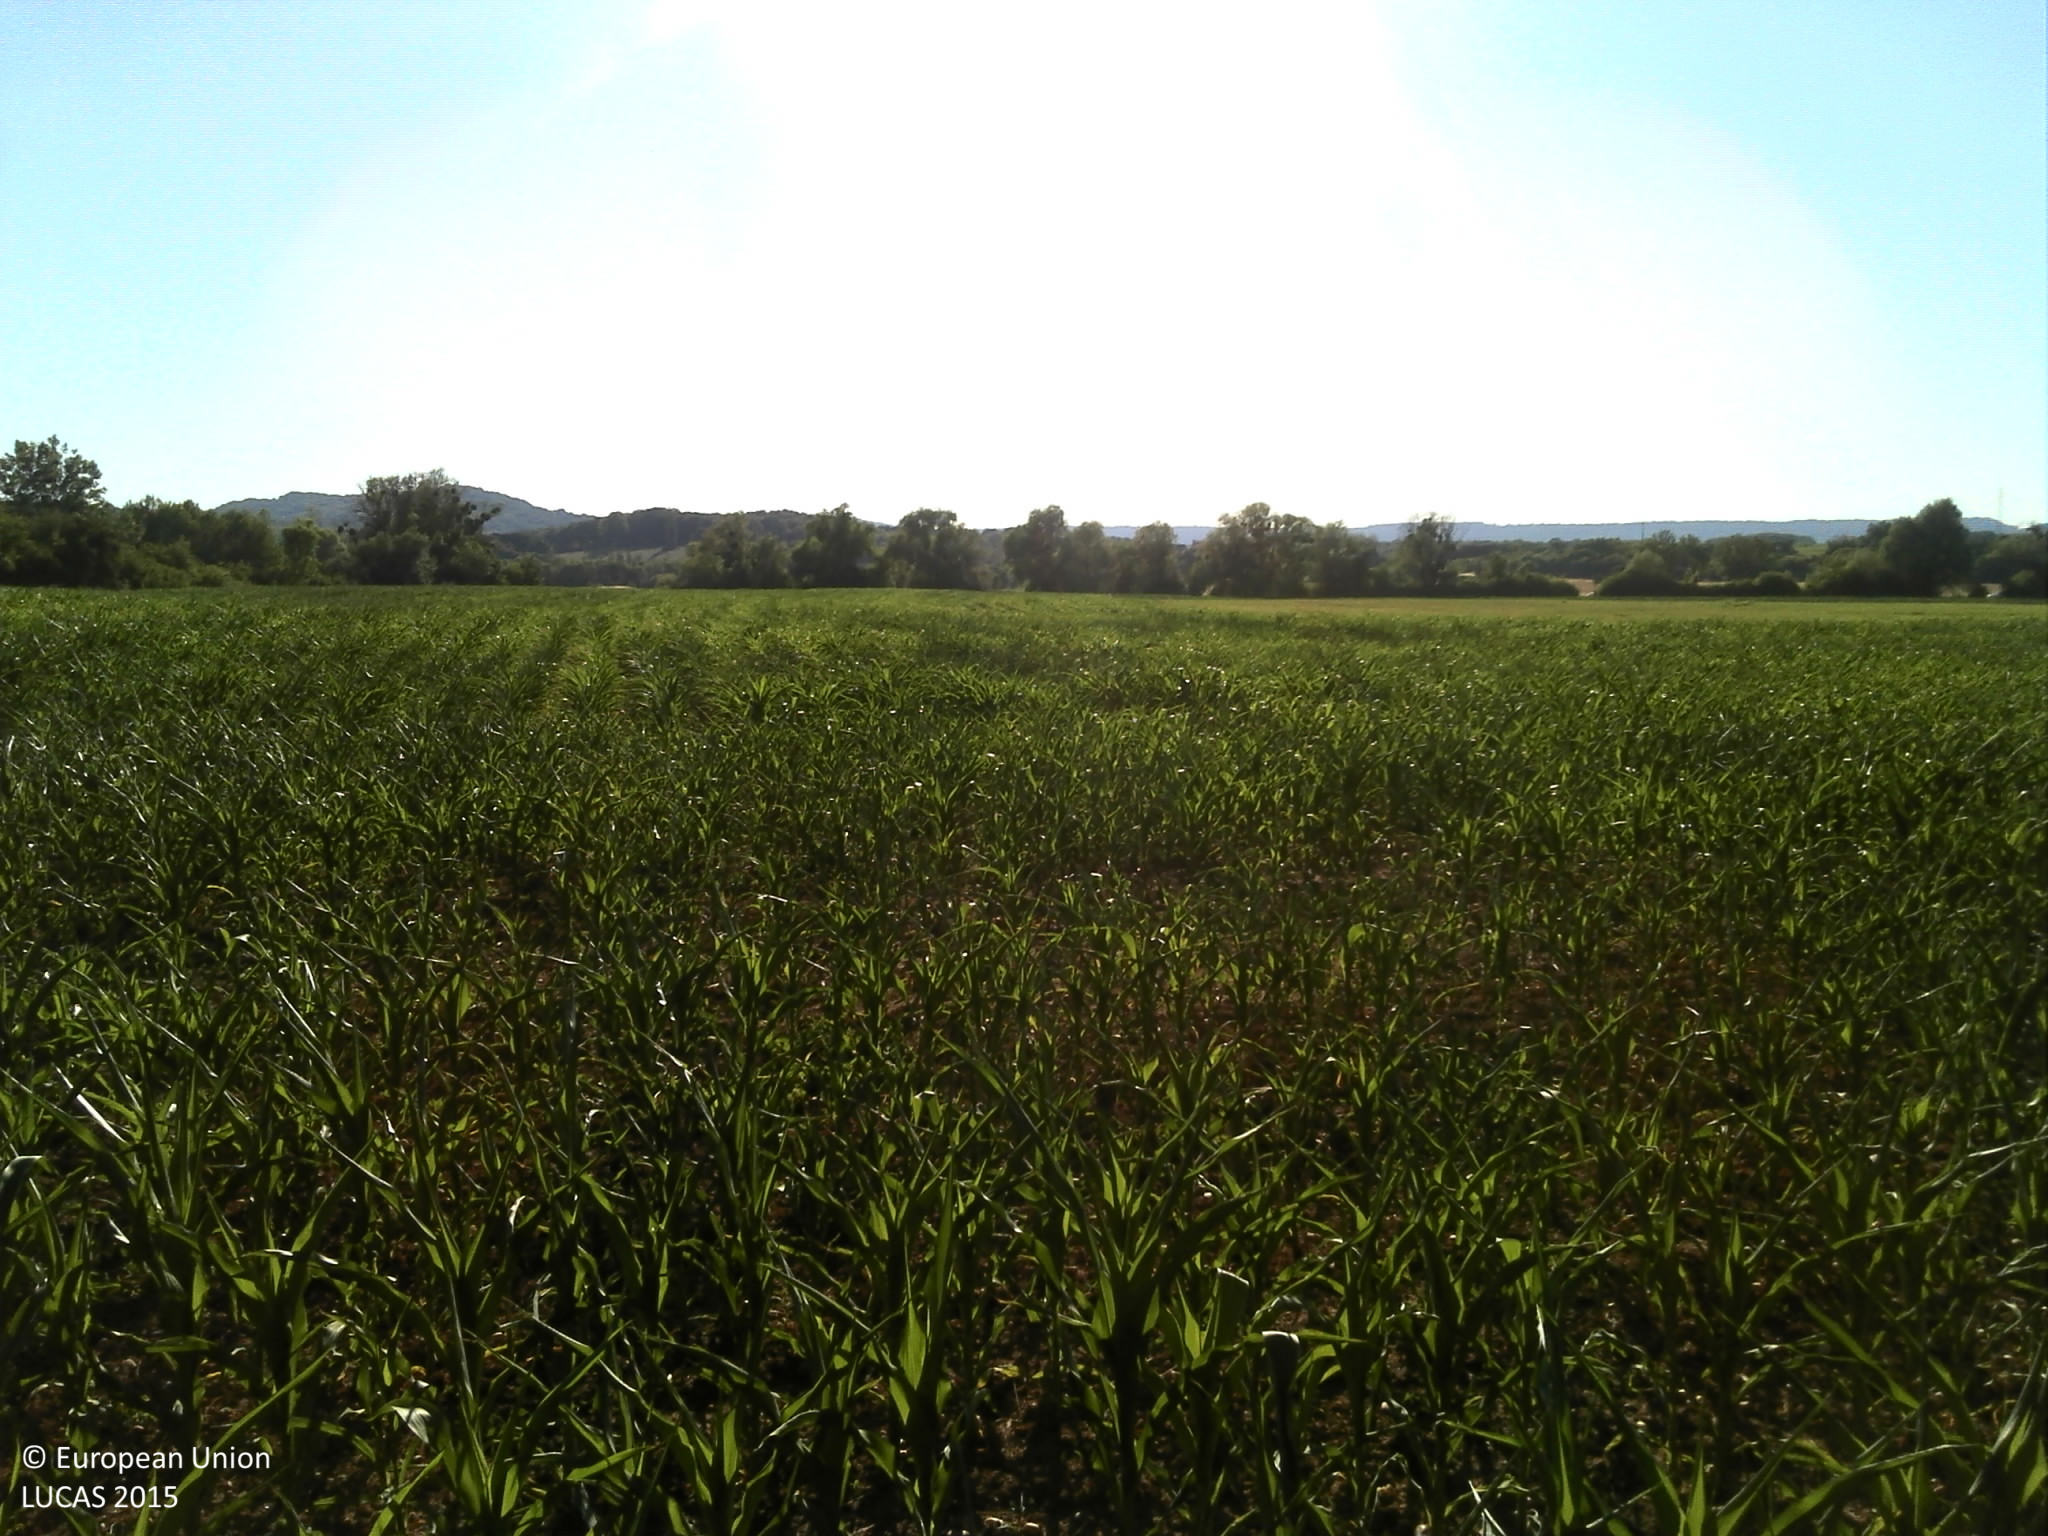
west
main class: Cropland
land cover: Maize
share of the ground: 25 - 50 %
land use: Agriculture (excluding fallow land and kitchen gardens)
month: June
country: FR
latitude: 49.3822
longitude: 6.1839
